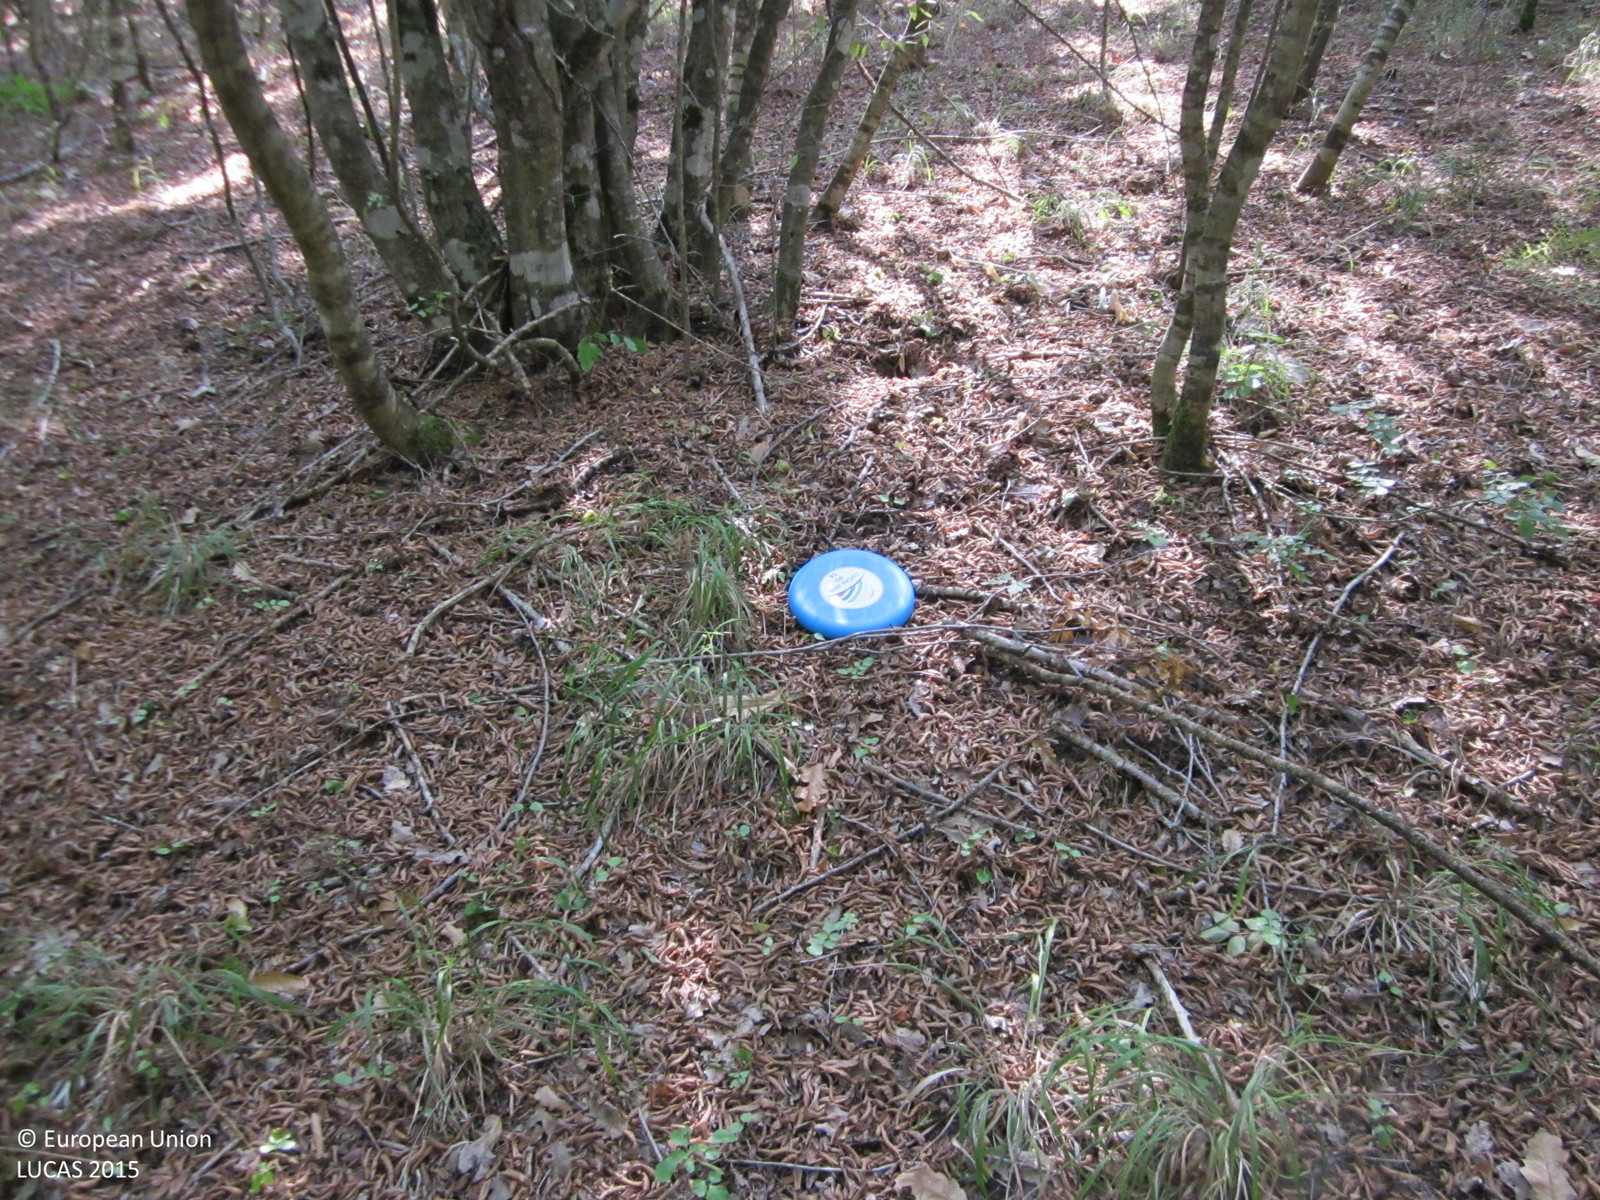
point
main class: Woodland
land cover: Broadleaved woodland
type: thermophilous deciduous forest
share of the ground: > 75 %
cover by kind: broadleaved forest trees 95 %, unconsolidated bare surface 5 %
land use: Forestry
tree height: > 5 m
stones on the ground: < 10 %
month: August
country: BG
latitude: 42.0358
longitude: 27.6177
